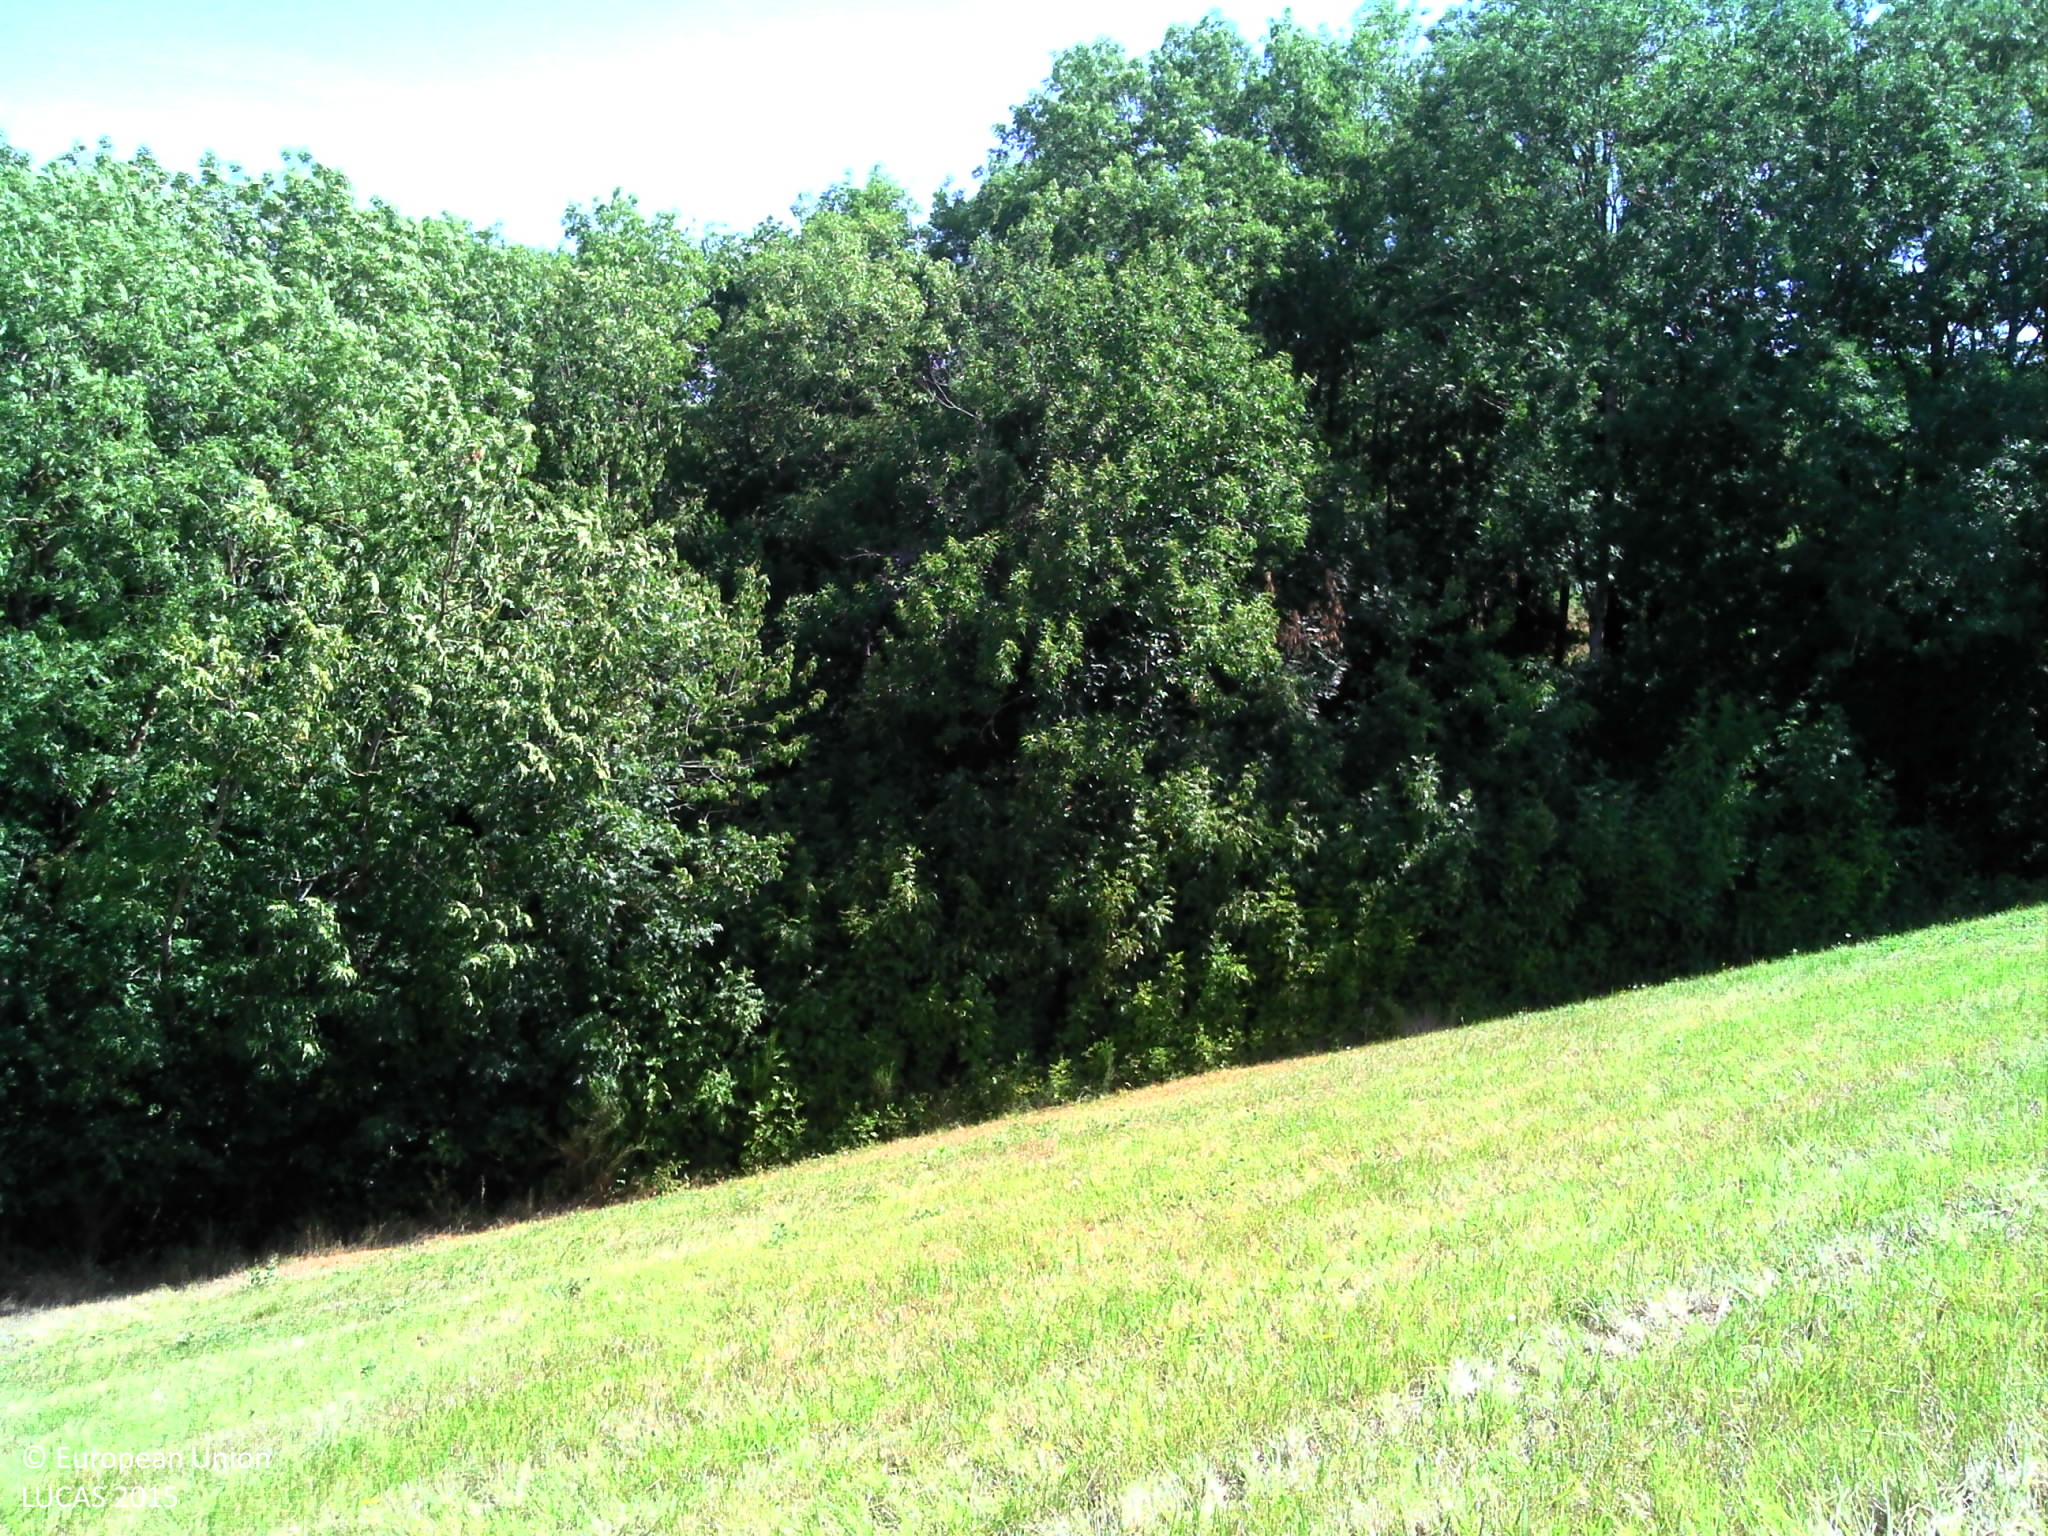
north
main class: Grassland
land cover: Grassland without tree/shrub cover
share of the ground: > 75 %
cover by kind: herbaceous plants 100 %
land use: Agriculture (excluding fallow land and kitchen gardens)
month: August
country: FR
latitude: 43.8445
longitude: 3.0289
